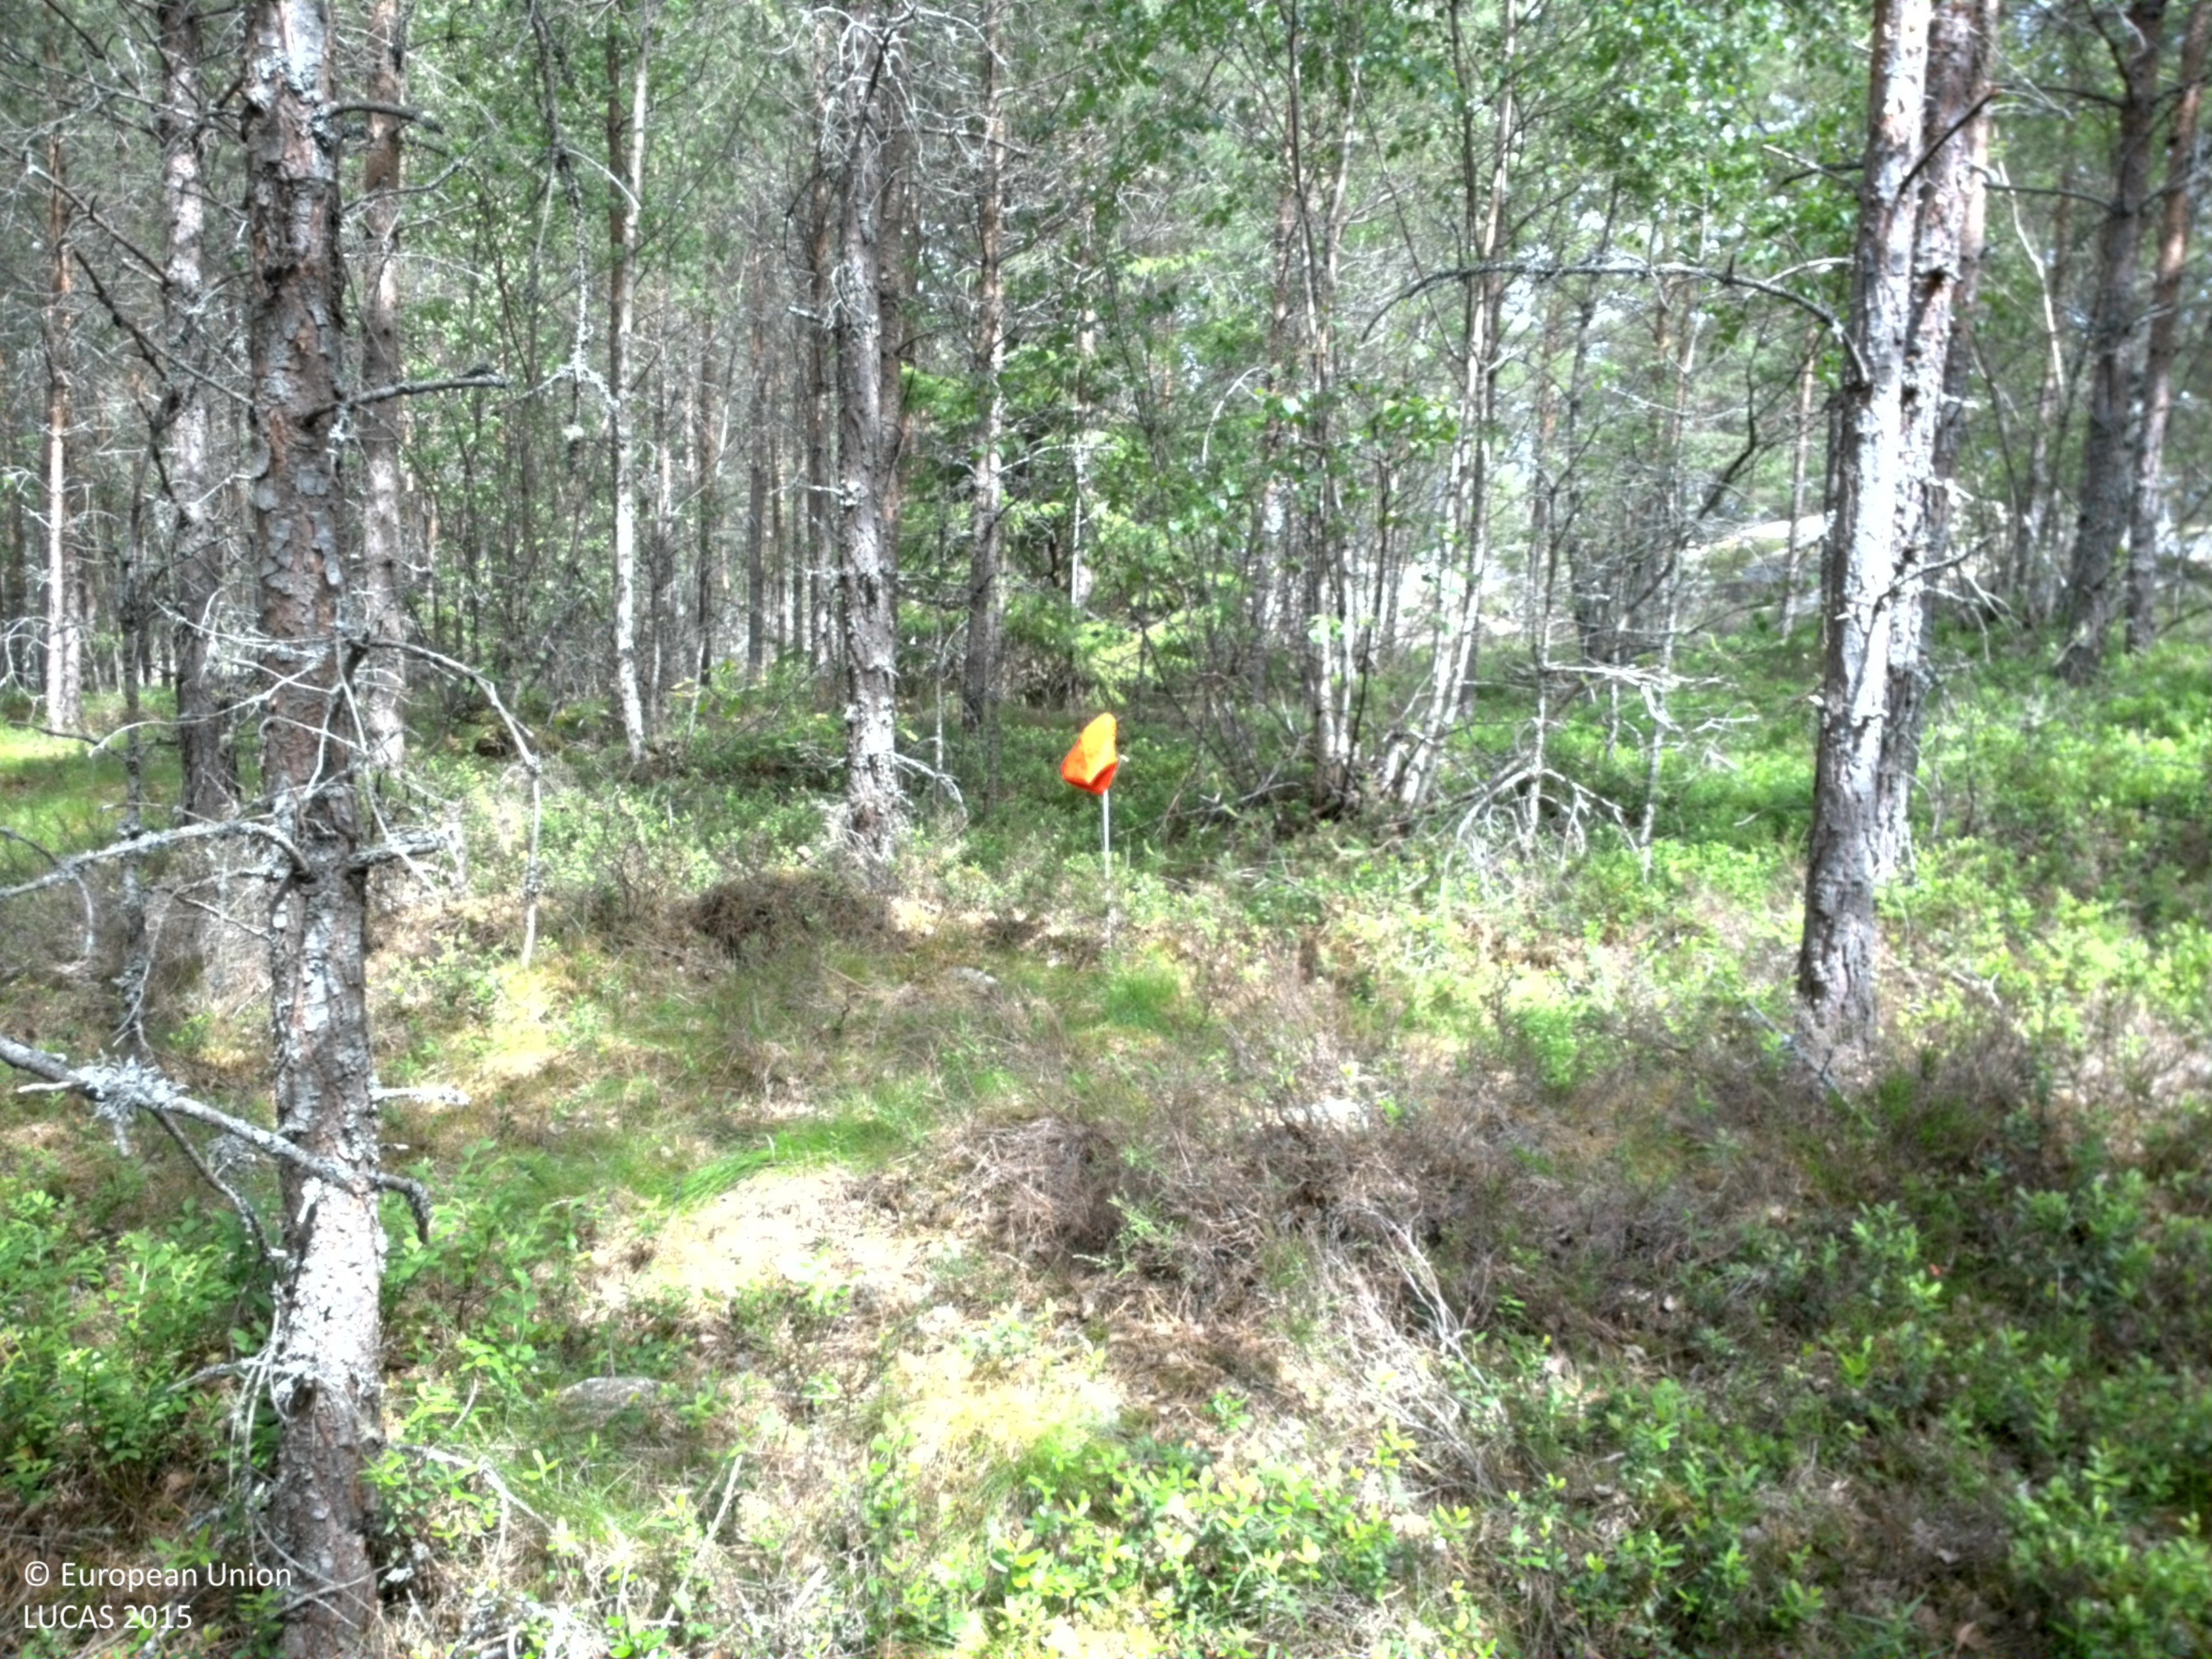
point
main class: Woodland
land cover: Pine dominated coniferous woodland
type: boreal forest
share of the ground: 25 - 50 %
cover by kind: coniferous forest trees 40 %, herbaceous plants 40 %, lichens and mosses 15 %, broadleaved forest trees 5 %
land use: Forestry
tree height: < 5 m
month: June
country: SE
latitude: 58.5295
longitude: 16.1605
